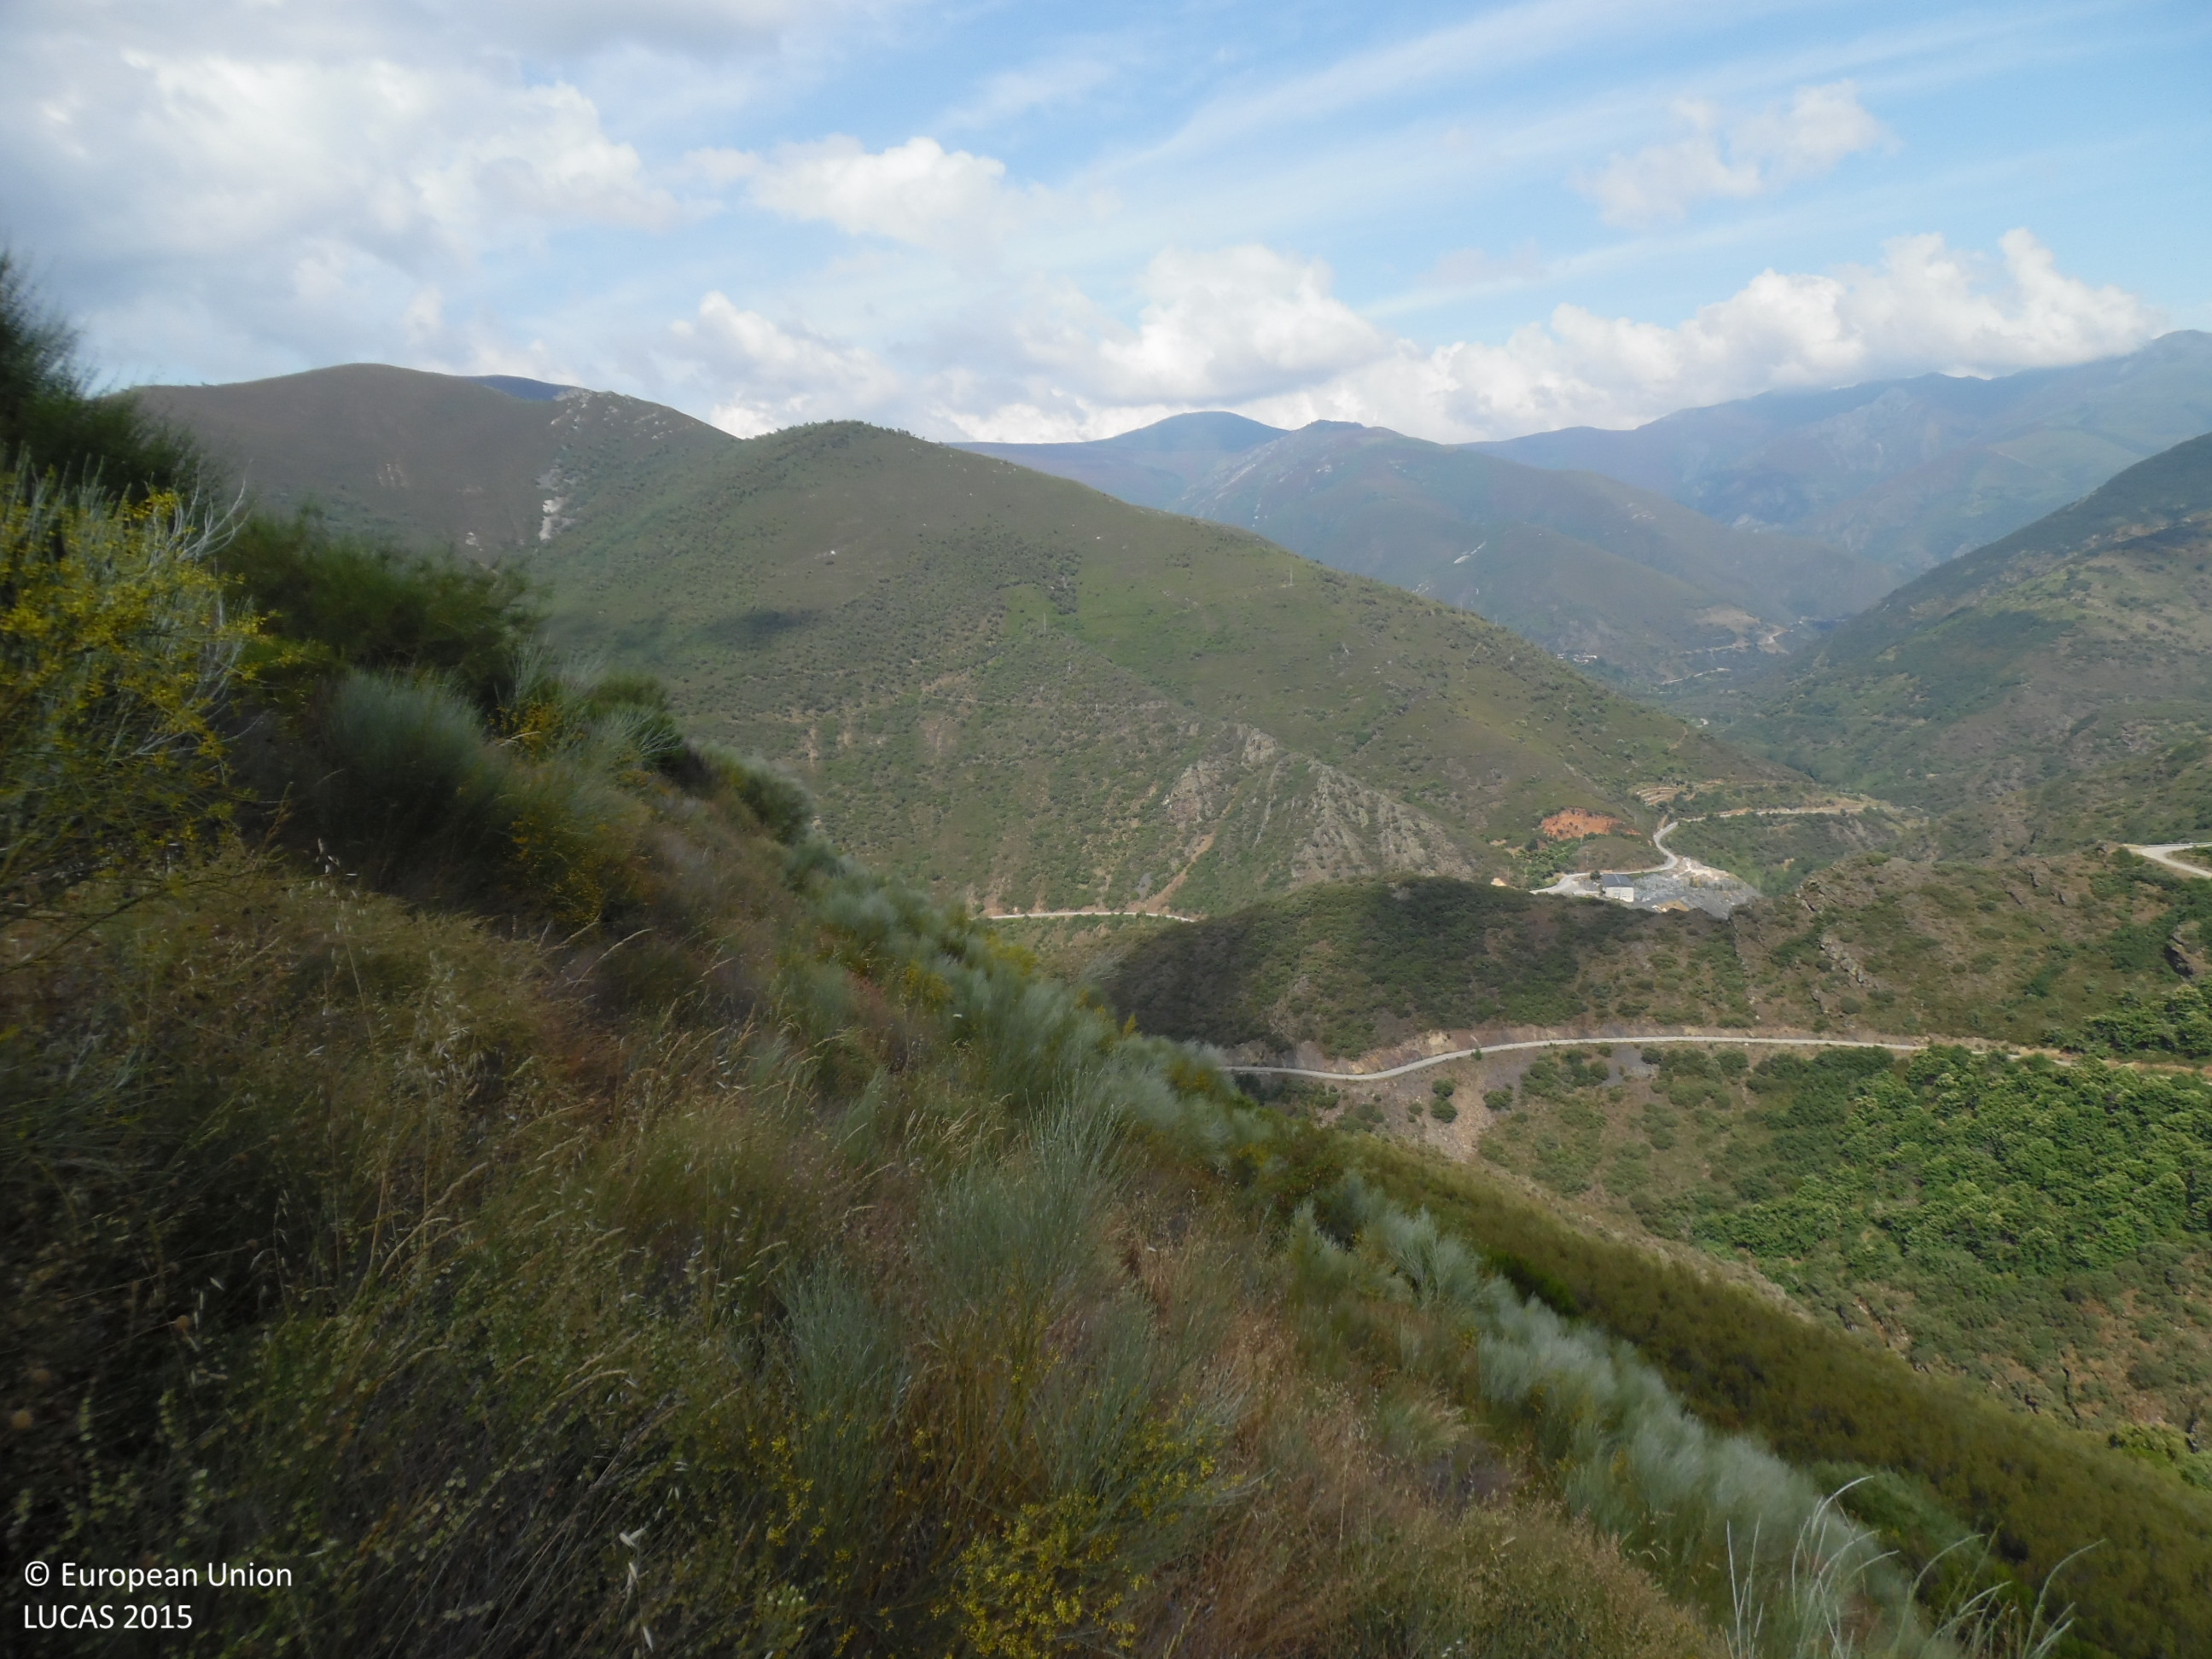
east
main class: Shrubland
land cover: Shrubland without tree cover
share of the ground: > 75 %
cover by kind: shrubs 100 %
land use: Abandoned areas
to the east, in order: Shrubland without tree cover; Shrubland with sparse tree cover; Broadleaved woodland
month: June
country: ES
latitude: 42.4140
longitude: -6.7078
